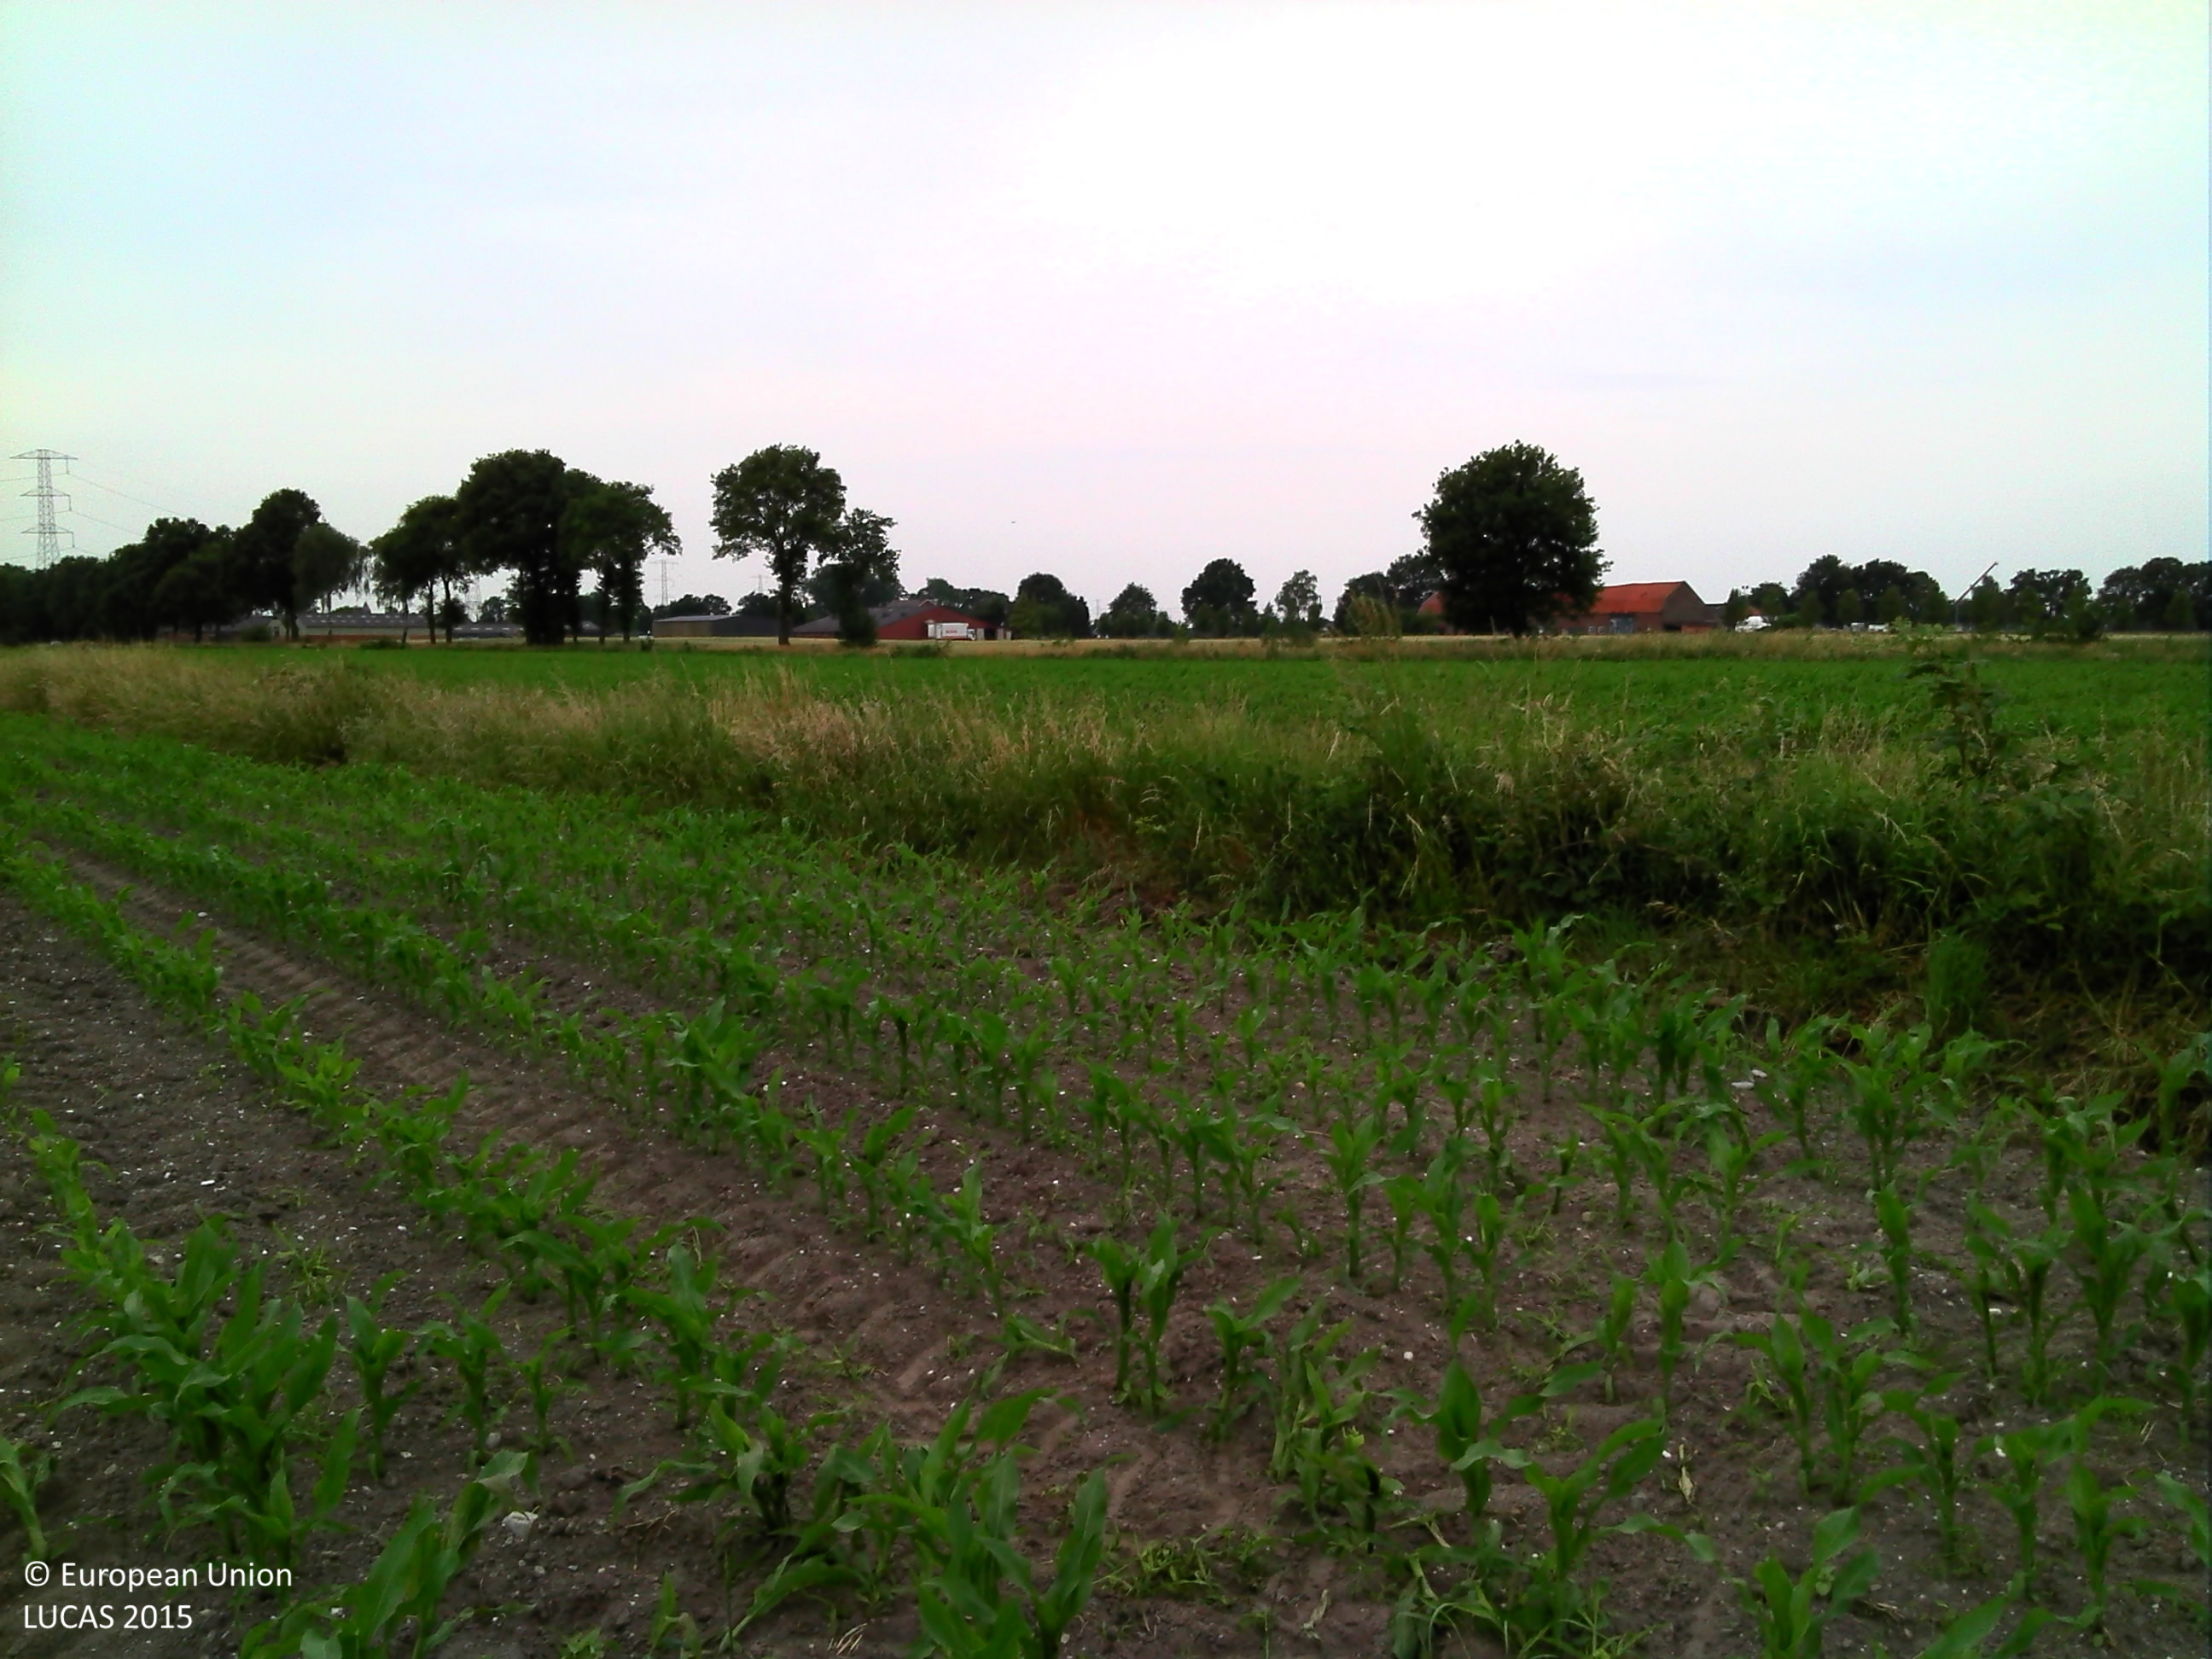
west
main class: Cropland
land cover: Maize
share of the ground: 10 - 25 %
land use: Agriculture (excluding fallow land and kitchen gardens)
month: June
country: BE
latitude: 51.1463
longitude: 5.6671
